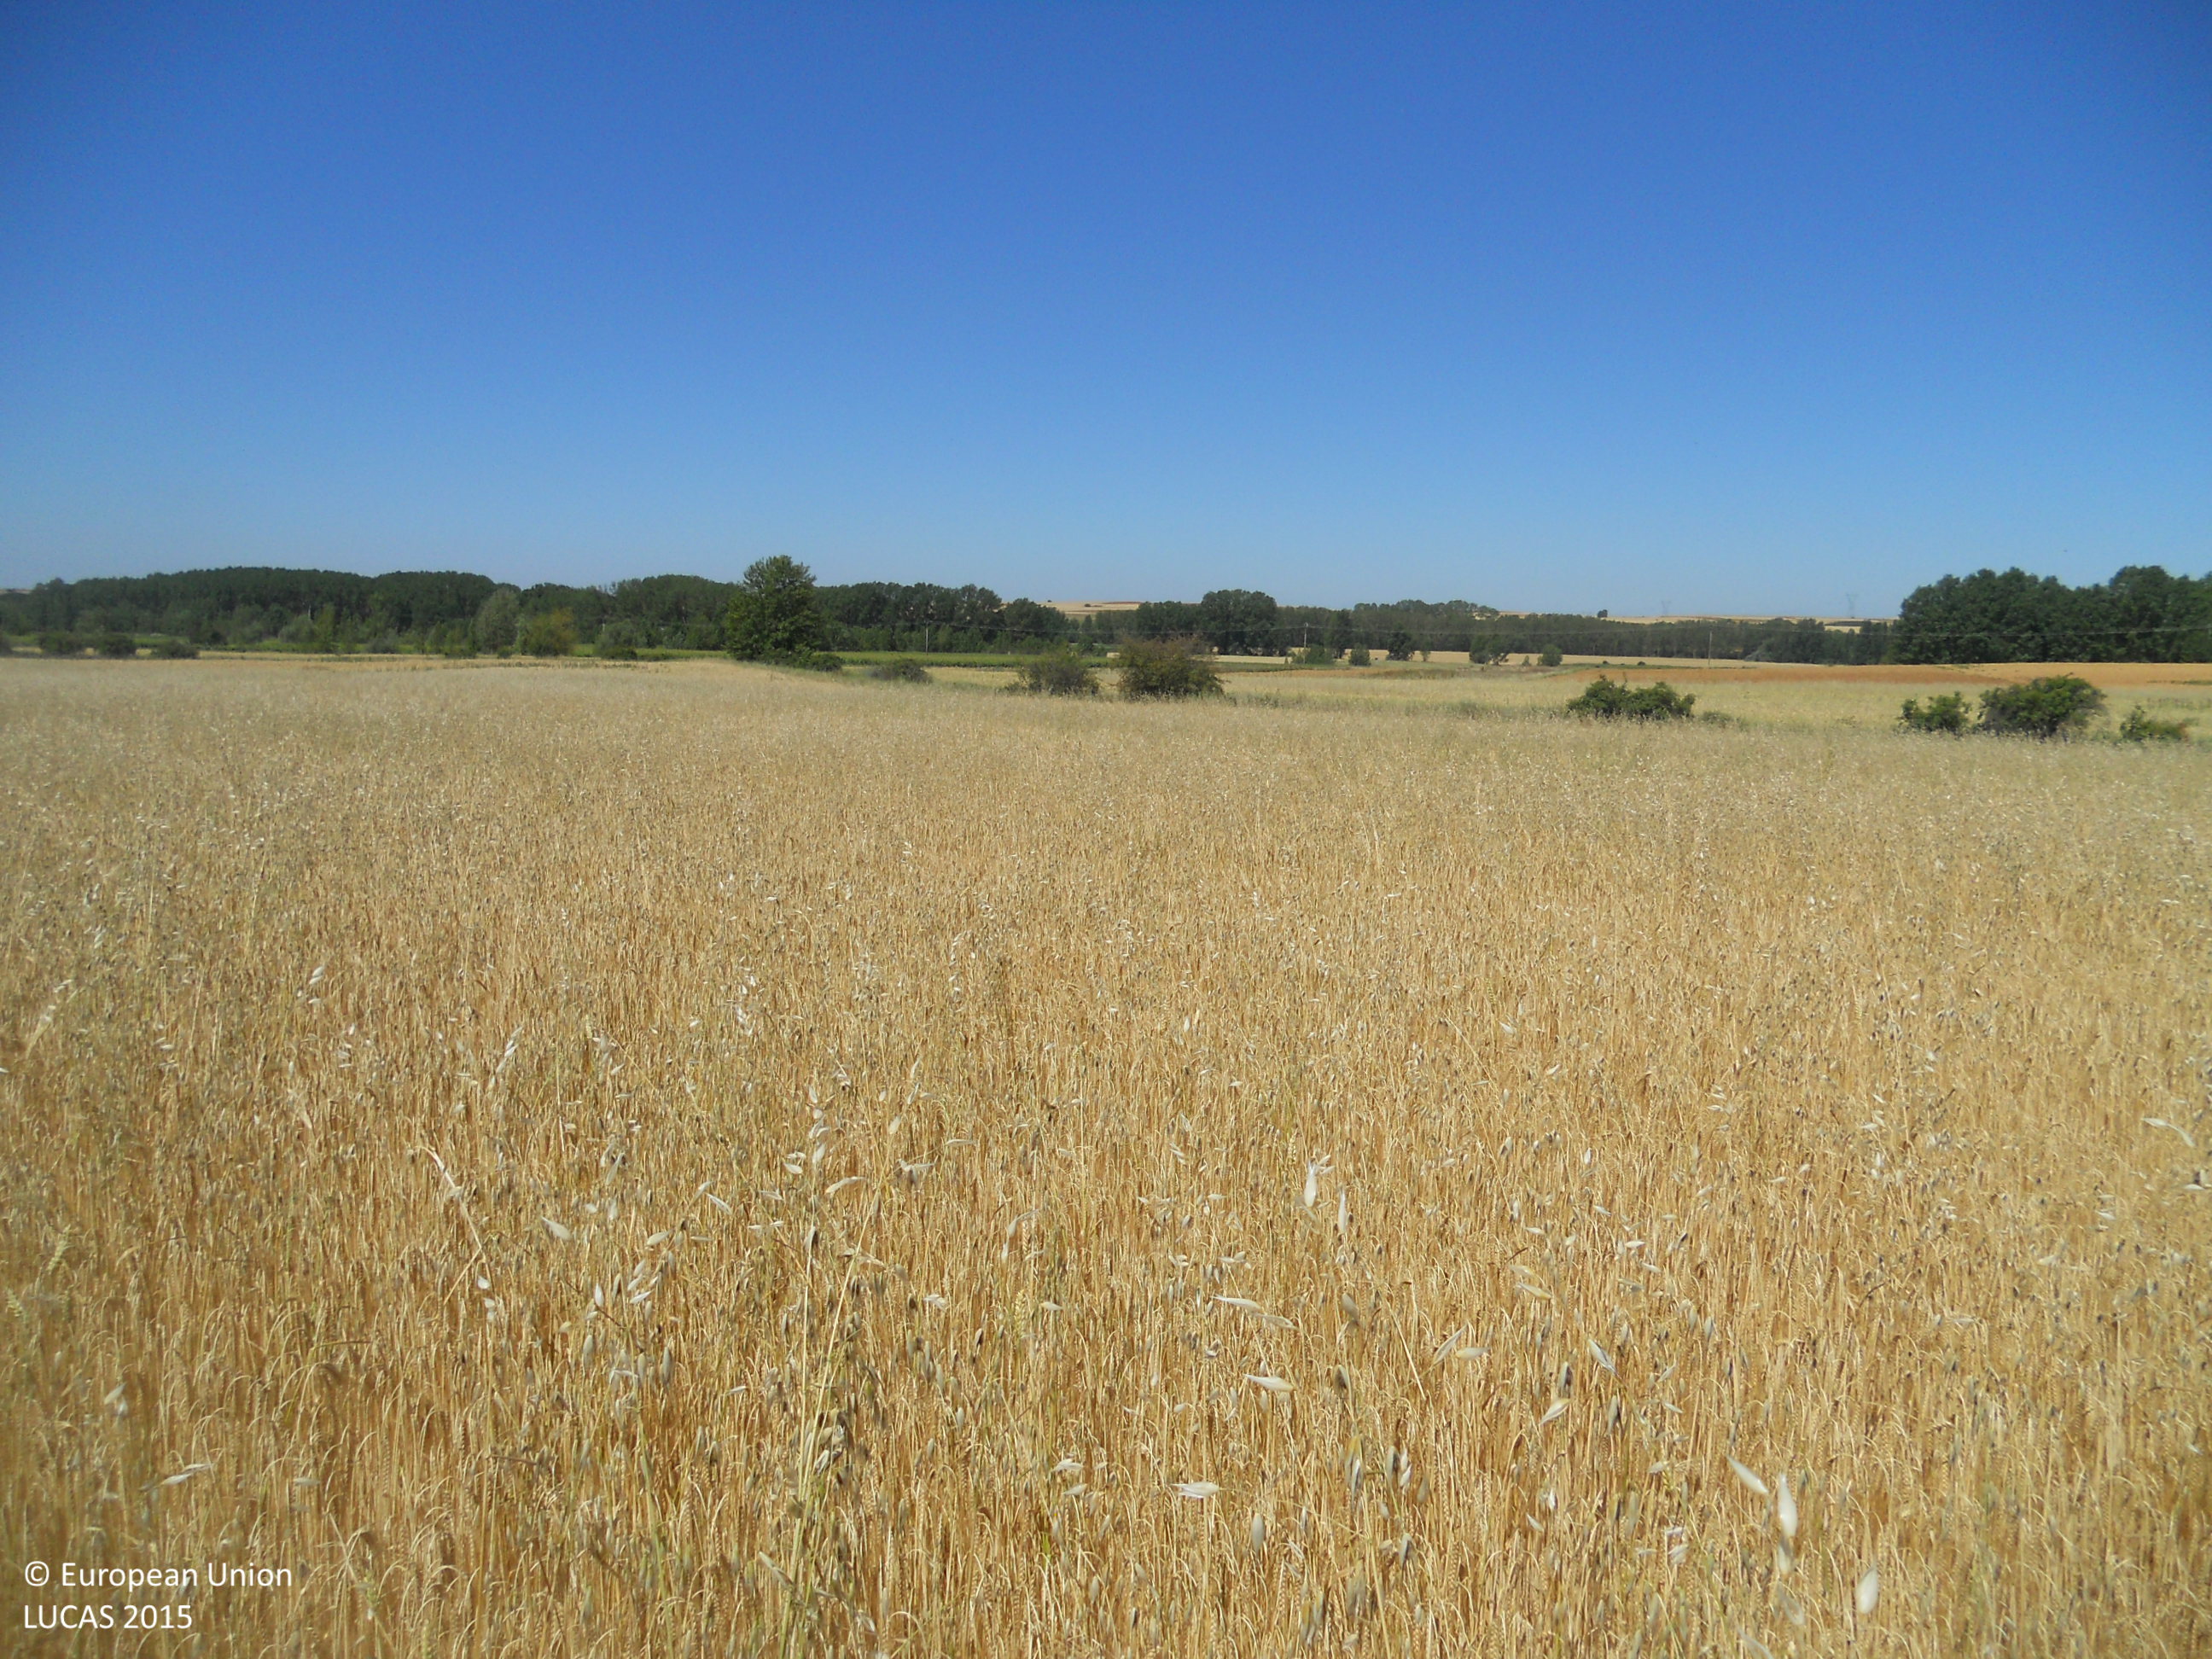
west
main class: Cropland
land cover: Barley
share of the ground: > 75 %
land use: Agriculture (excluding fallow land and kitchen gardens)
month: June
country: ES
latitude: 42.4145
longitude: -4.9691
